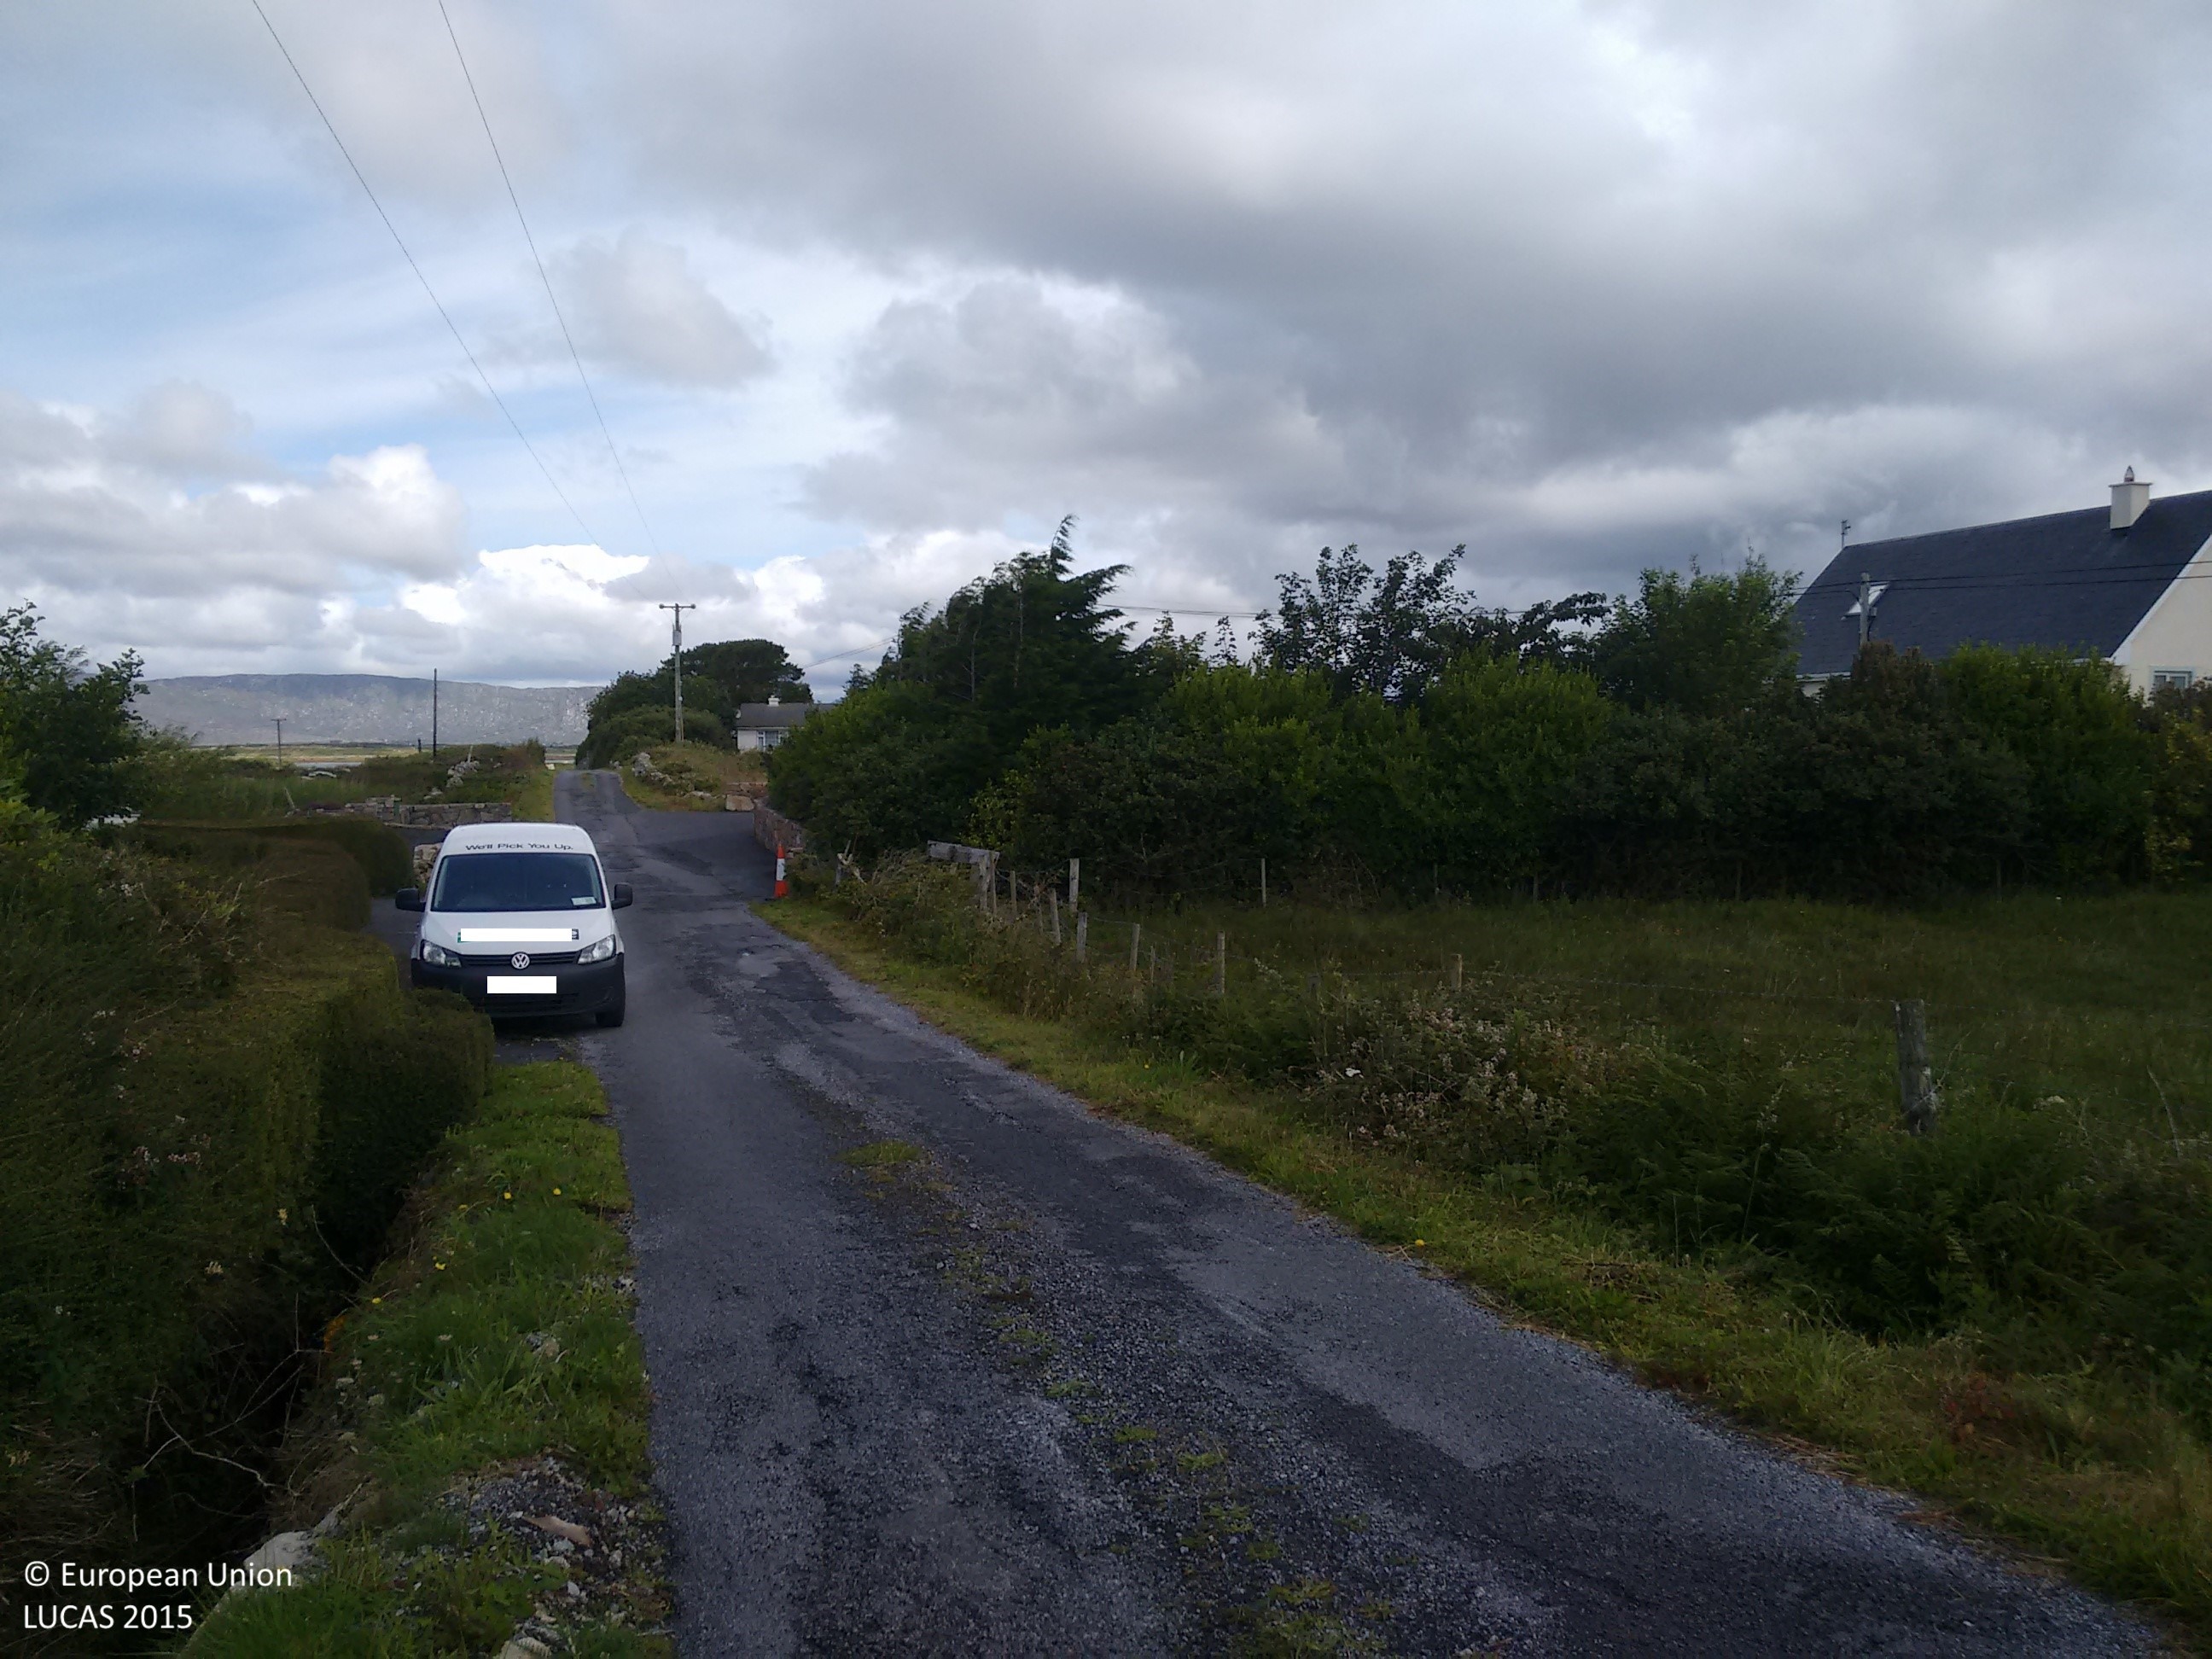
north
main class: Woodland
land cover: Pine dominated mixed woodland
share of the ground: 50 - 75 %
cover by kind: coniferous forest trees 75 %, broadleaved forest trees 25 %
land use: Residential
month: July
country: IE
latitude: 53.3031
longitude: -9.6727
